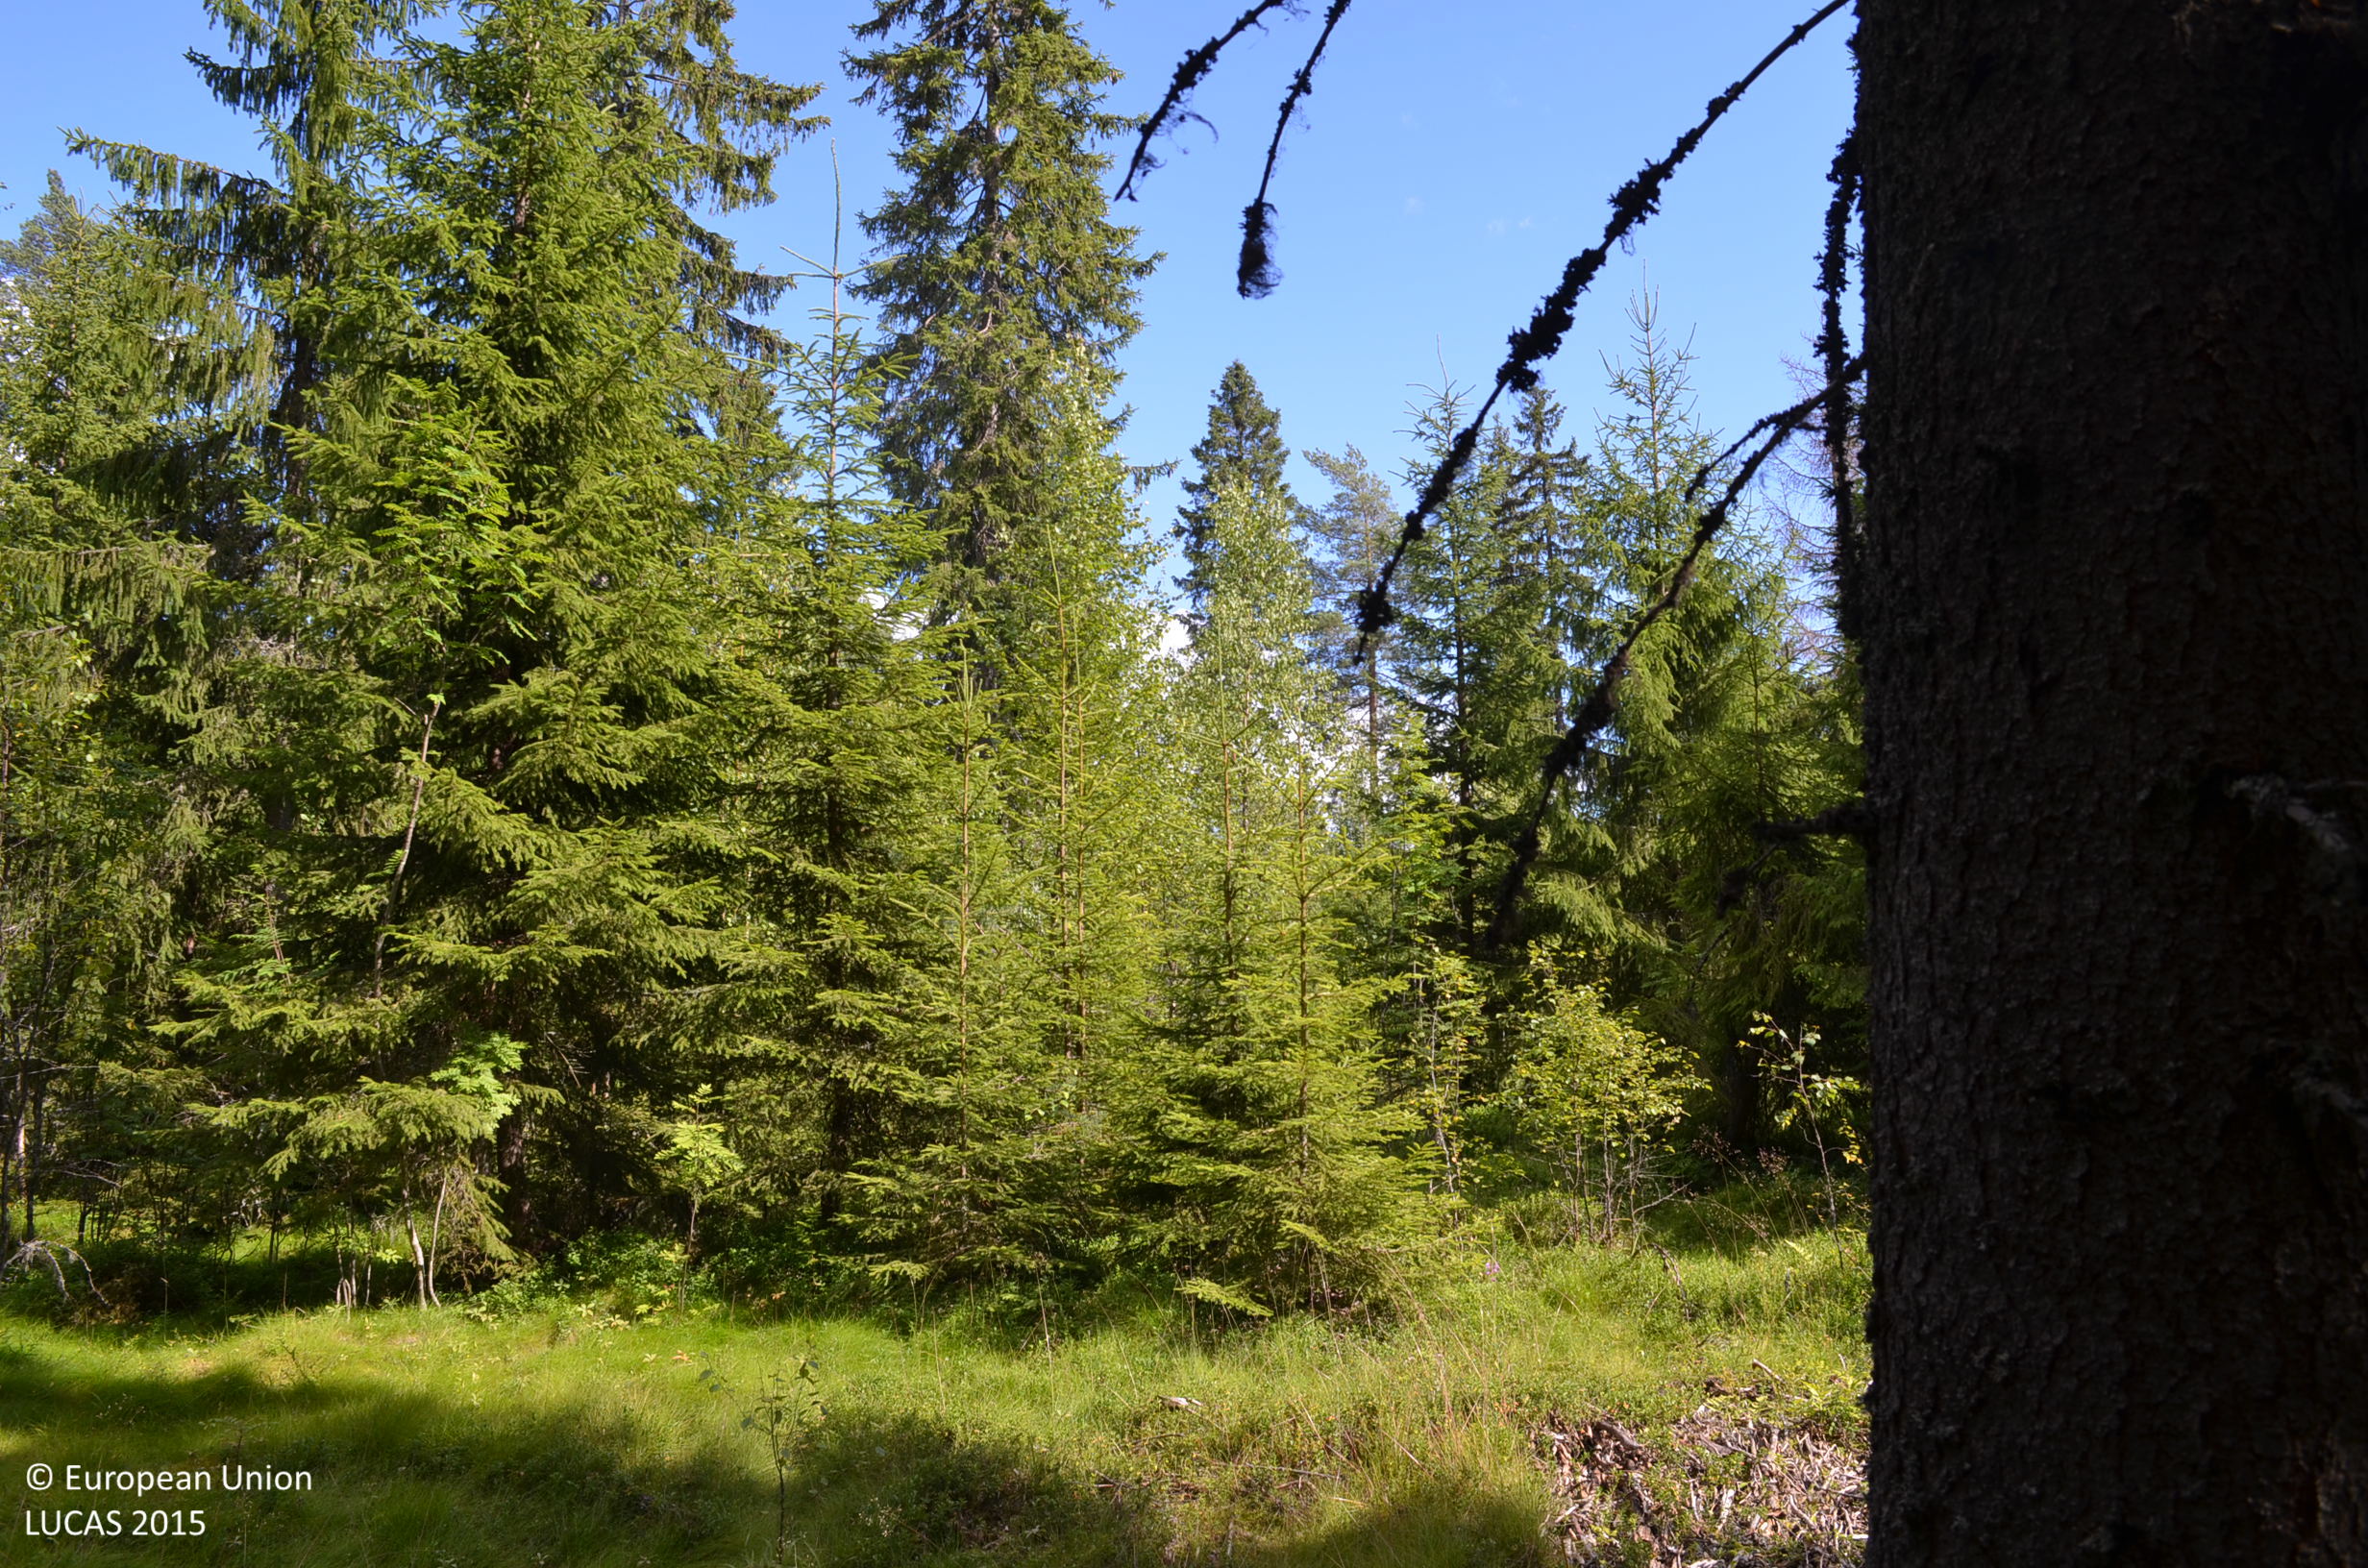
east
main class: Woodland
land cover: Spruce dominated coniferous woodland
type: boreal forest
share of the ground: > 75 %
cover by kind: coniferous forest trees 75 %, broadleaved forest trees 10 %, shrubs 10 %, lichens and mosses 5 %
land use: Forestry
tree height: > 5 m
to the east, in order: Spruce dominated coniferous woodland; Spruce dominated mixed woodland; Ditches and canals; Spruce dominated mixed woodland; Ditches and canals; Spruce dominated mixed woodland; Ditches and canals; Spruce dominated mixed woodland; Other mixed woodland
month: August
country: FI
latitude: 61.6398
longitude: 23.0352
